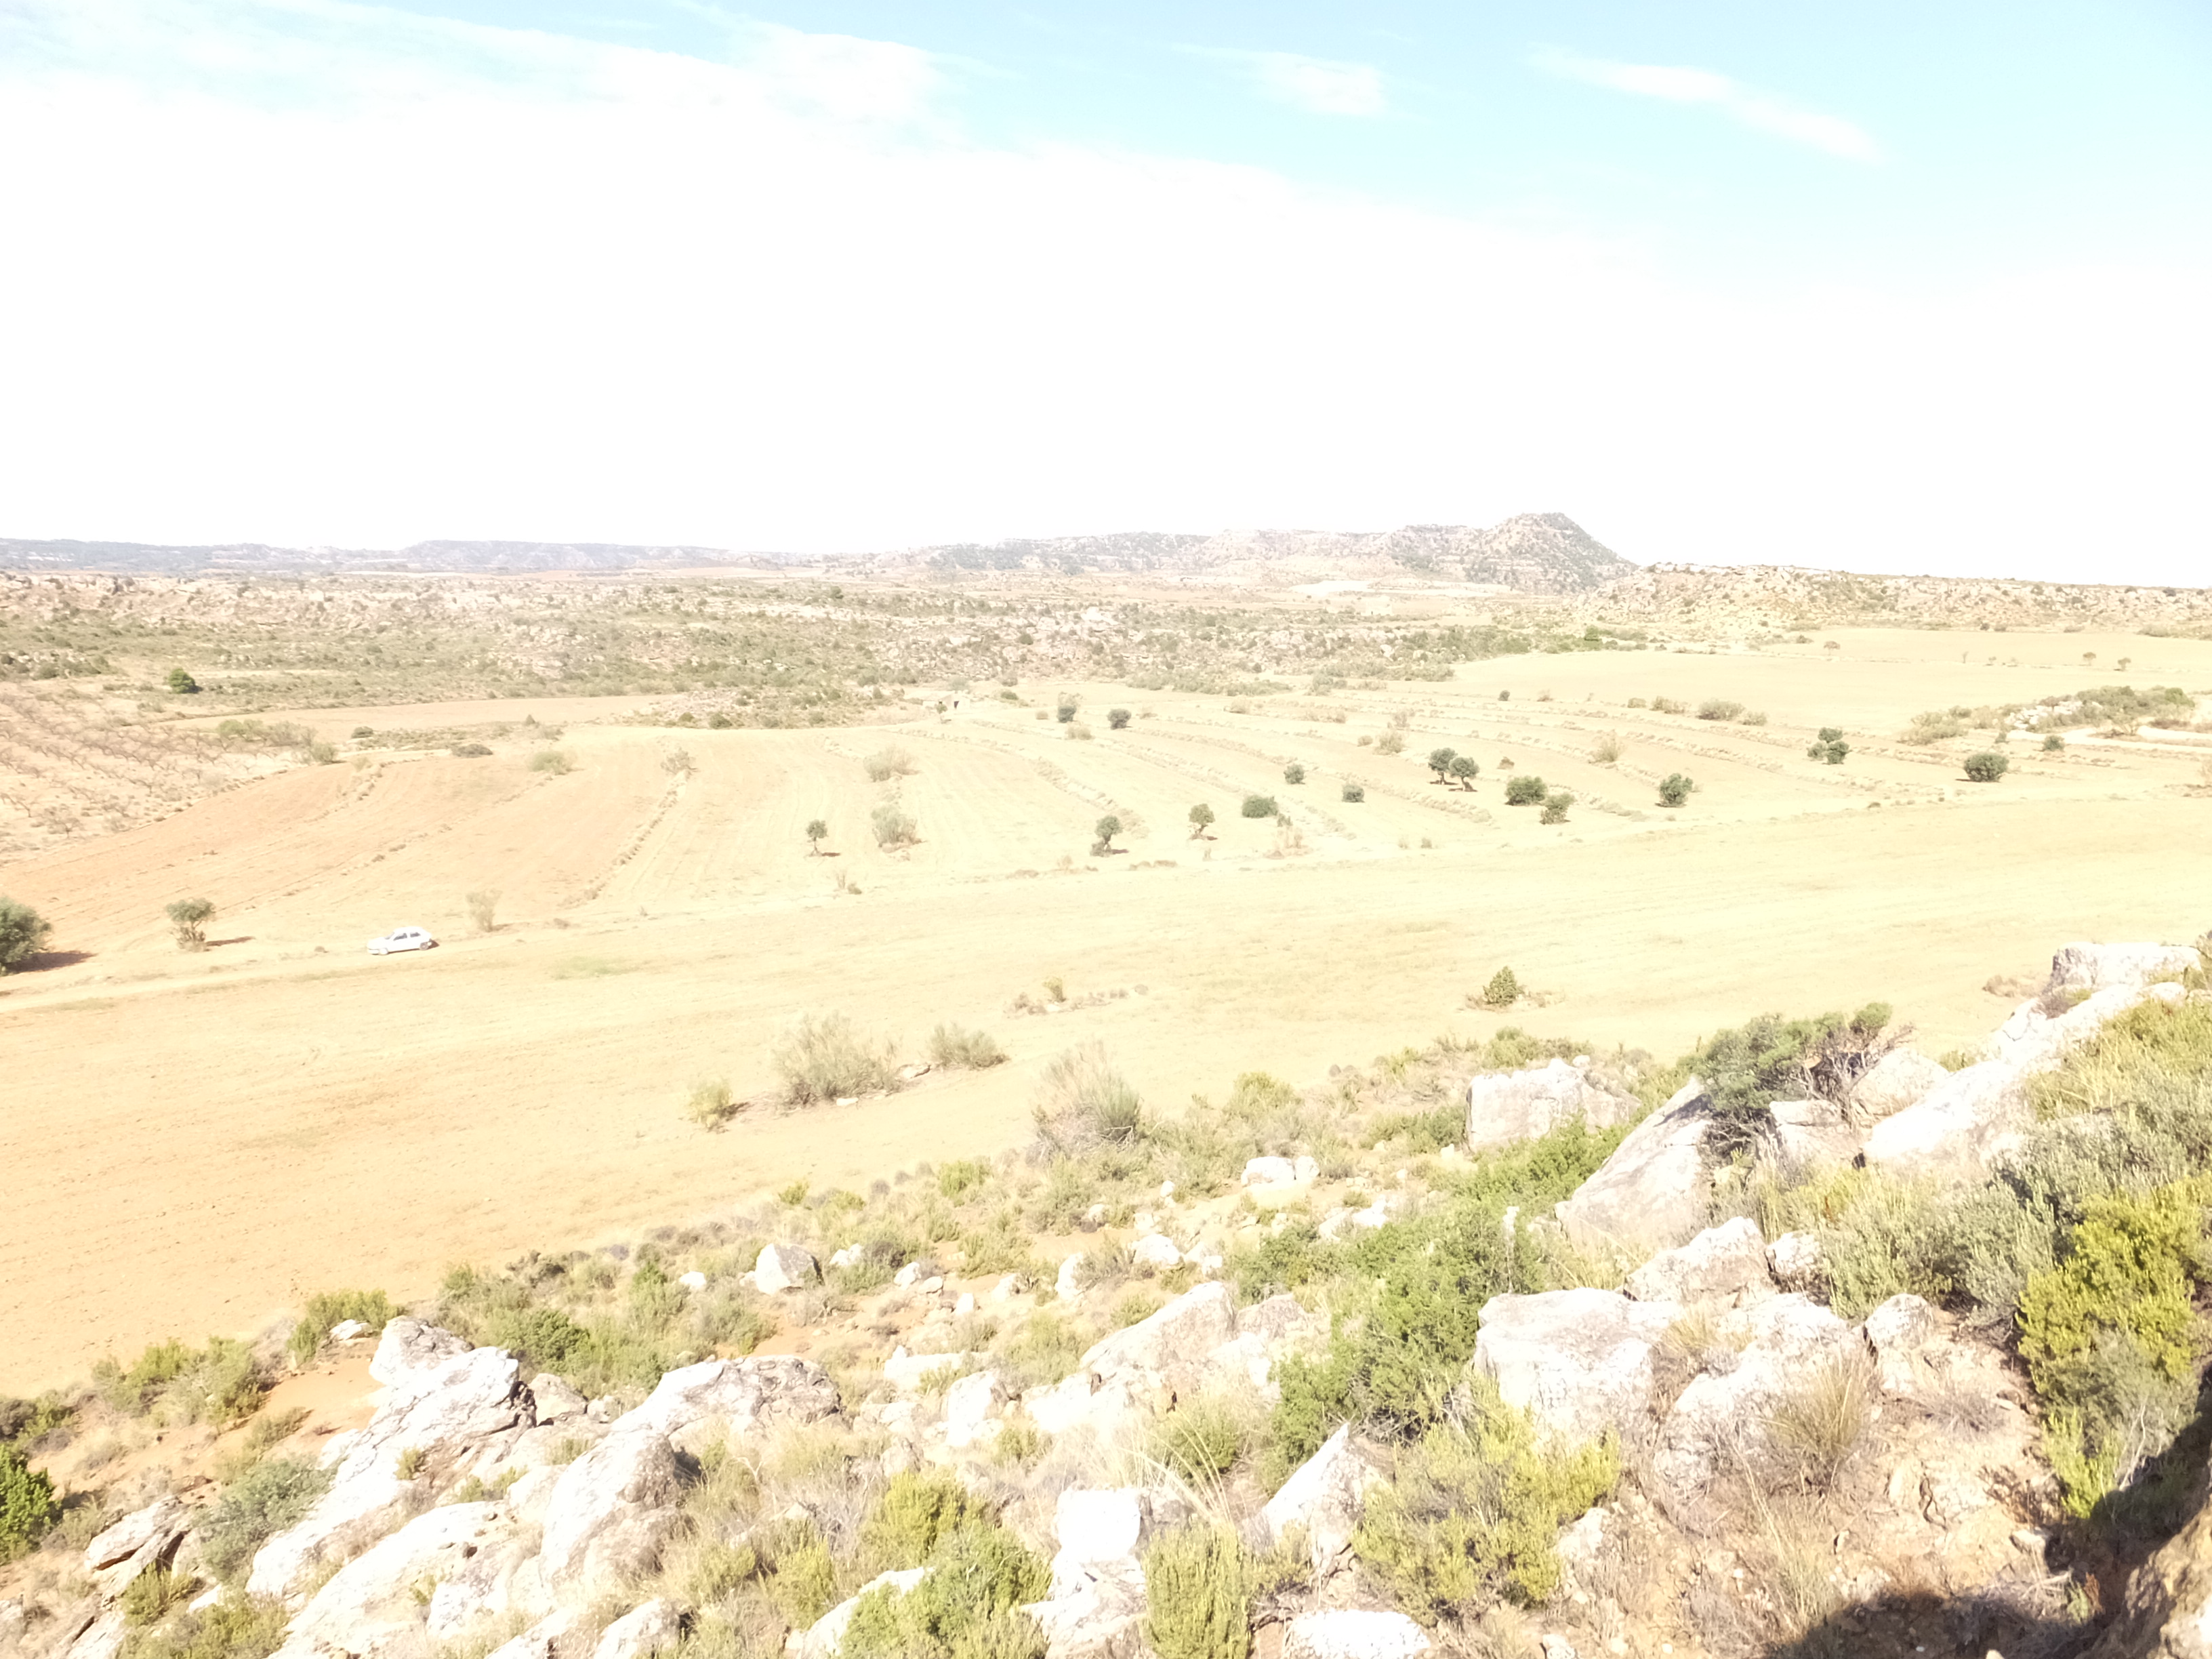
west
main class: Shrubland
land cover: Shrubland without tree cover
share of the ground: > 75 %
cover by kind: consolidated bare surface 50 %, shrubs 30 %, herbaceous plants 20 %
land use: Semi-natural and natural areas not in use
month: July
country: ES
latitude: 41.1540
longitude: -0.0333
